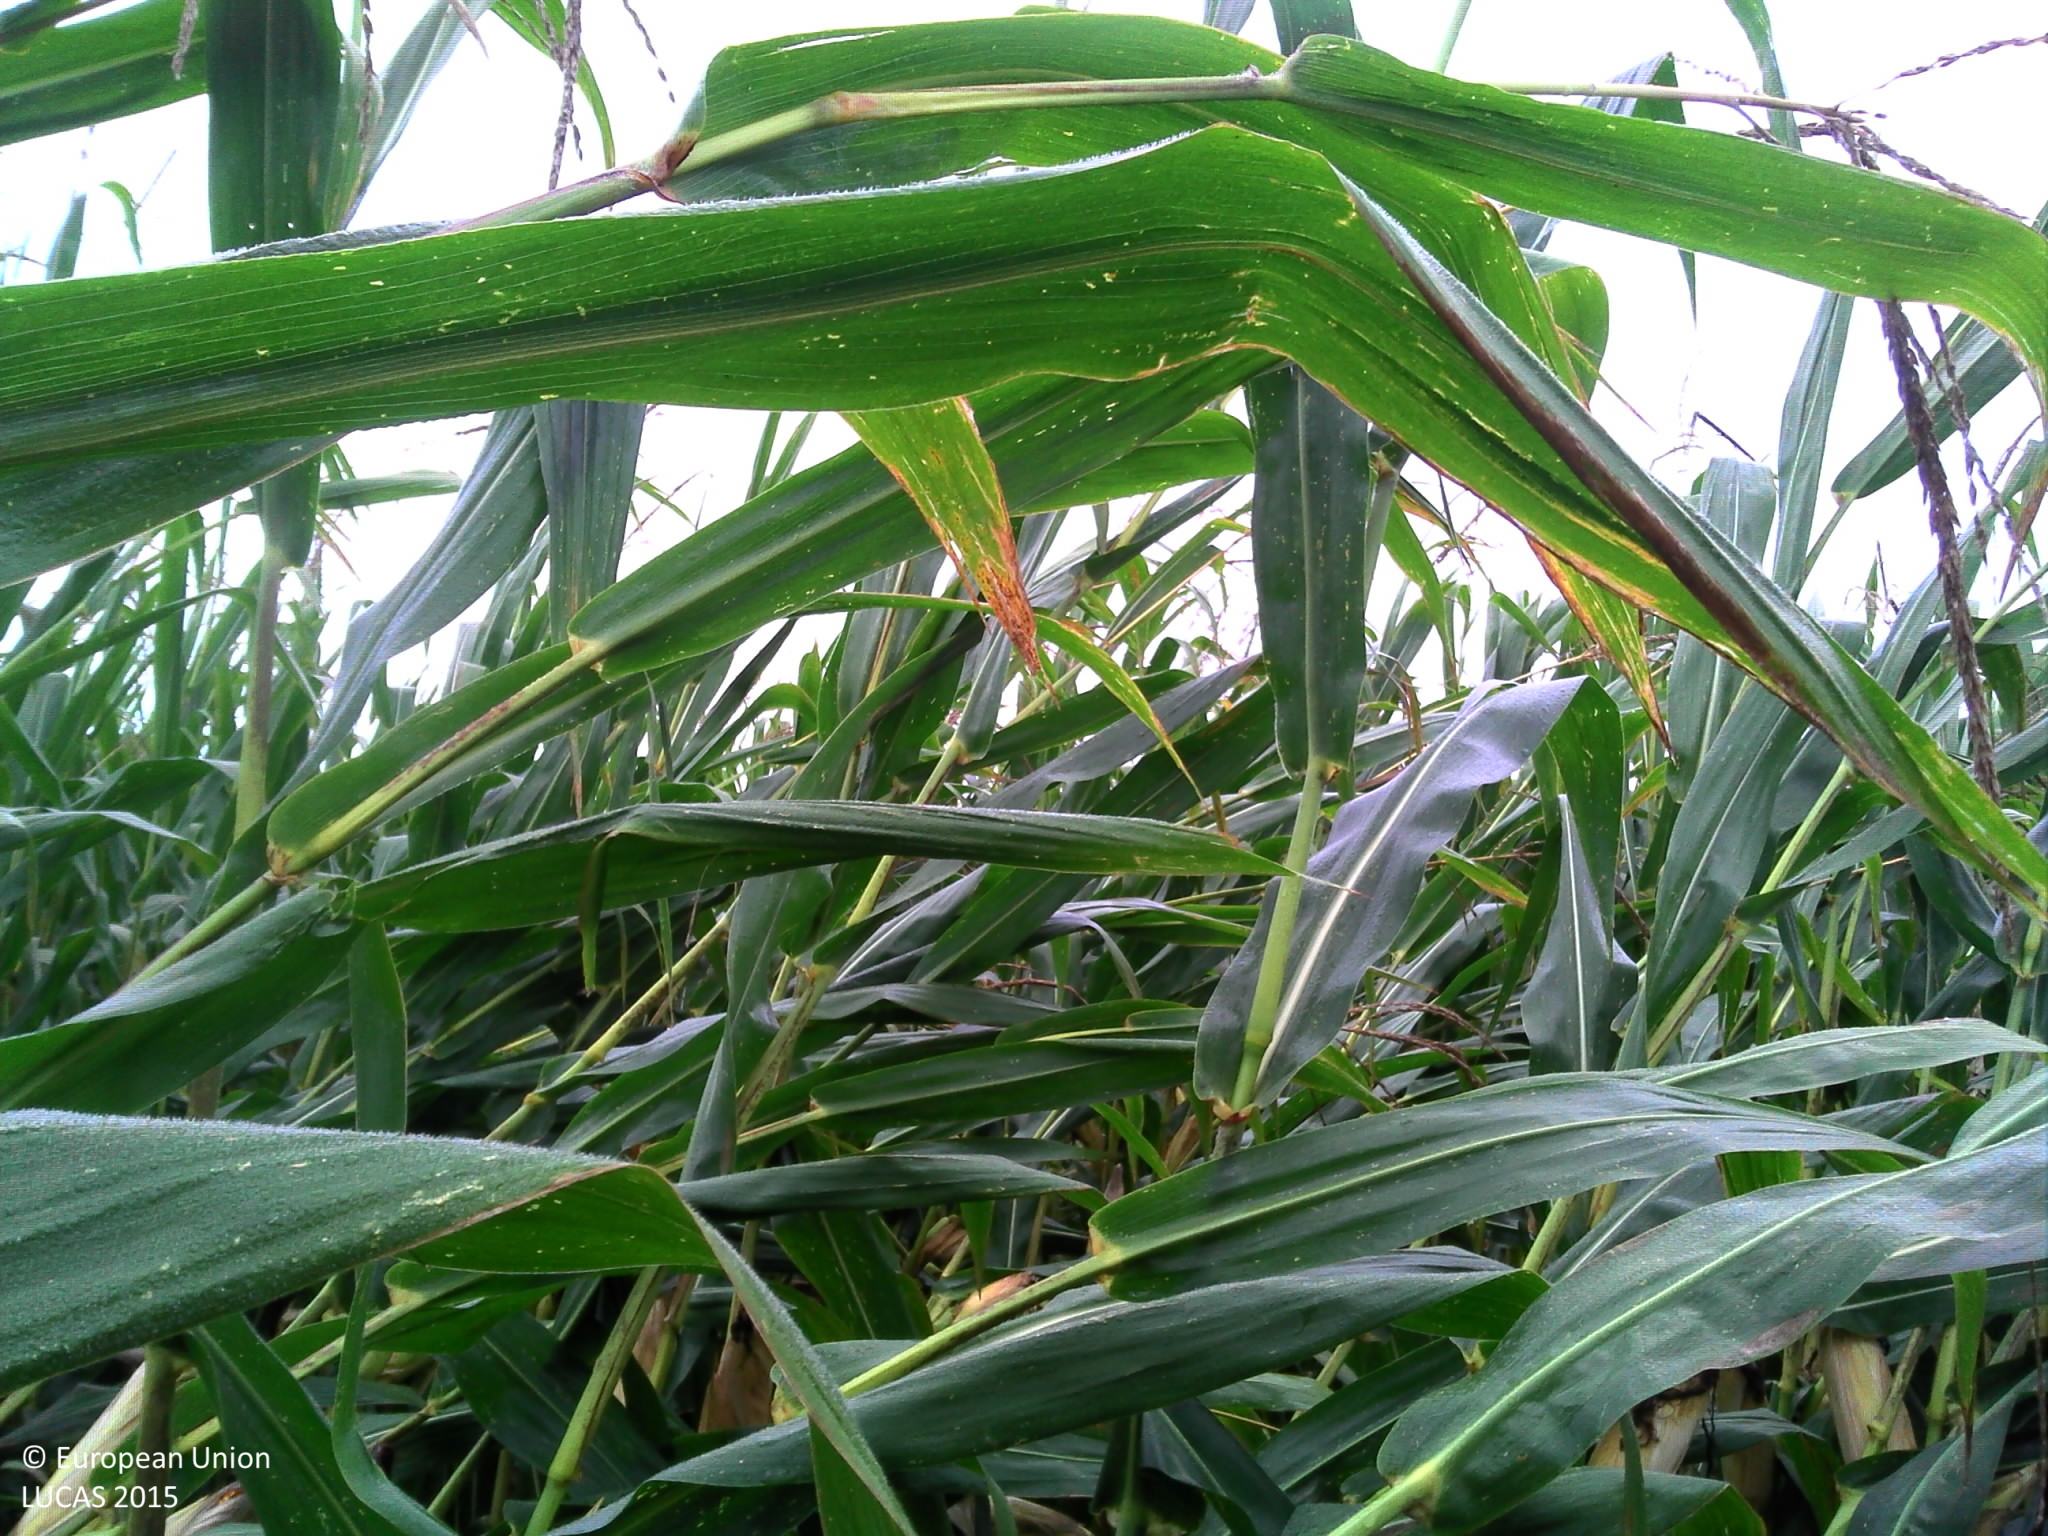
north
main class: Cropland
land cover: Maize
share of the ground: > 75 %
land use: Agriculture (excluding fallow land and kitchen gardens)
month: September
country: FR
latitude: 43.4859
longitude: -0.5317
